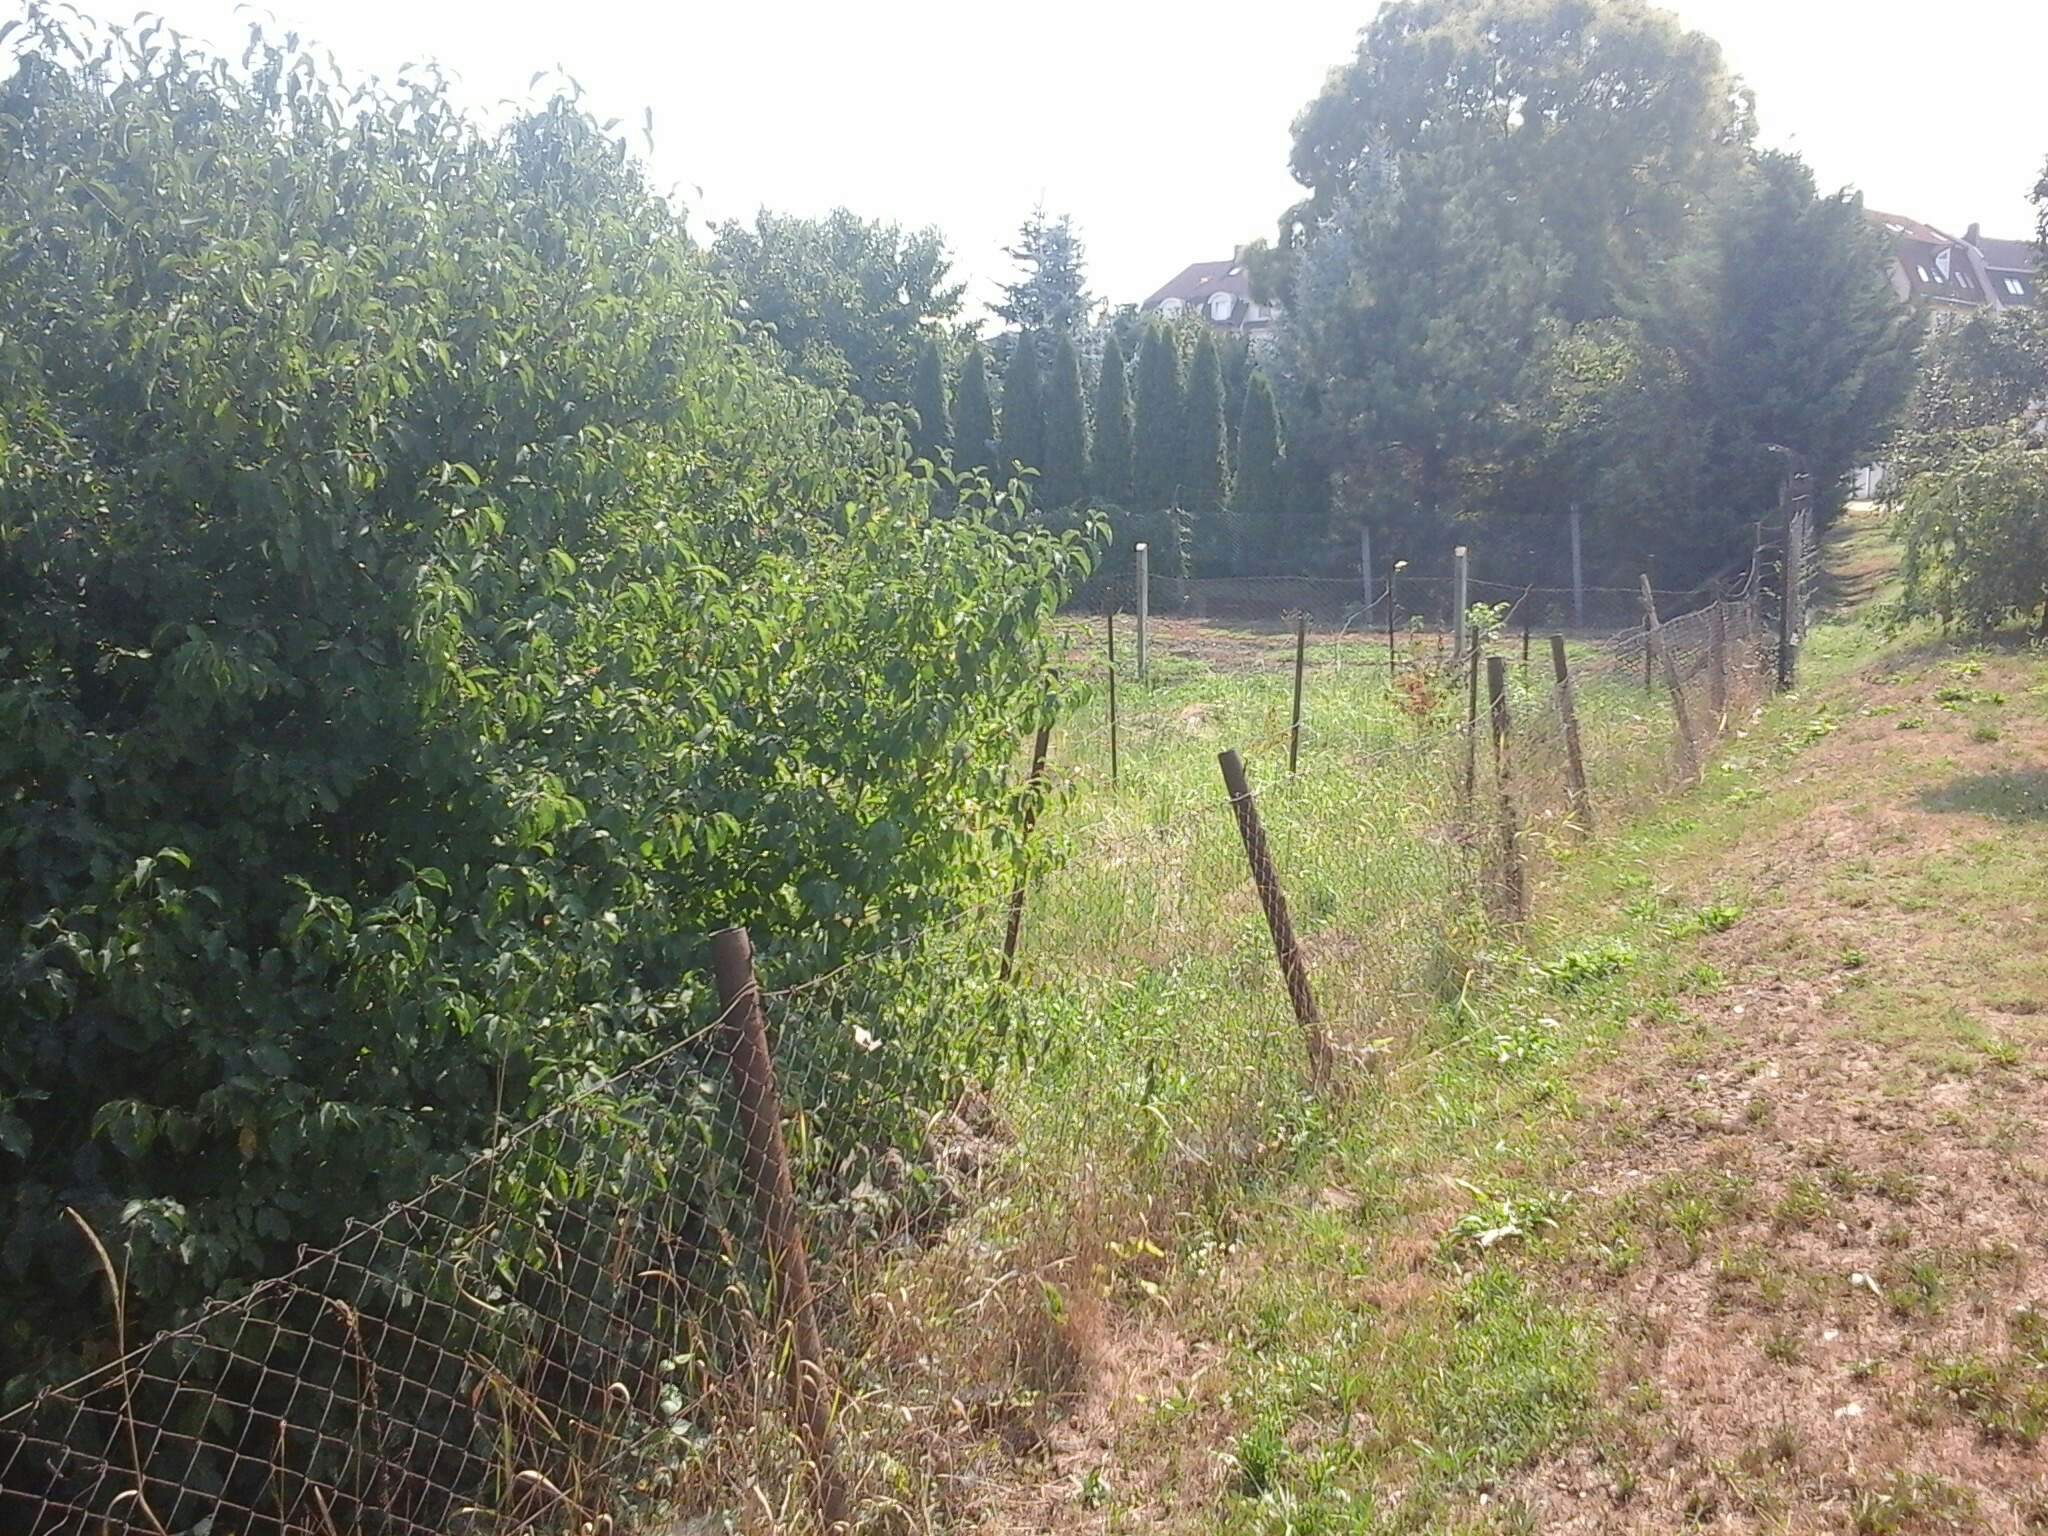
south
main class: Cropland
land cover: Vineyards
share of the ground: 10 - 25 %
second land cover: Grassland without tree/shrub cover
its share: 50 - 75 %
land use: Kitchen garden
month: August
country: HU
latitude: 48.0834
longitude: 19.2980
